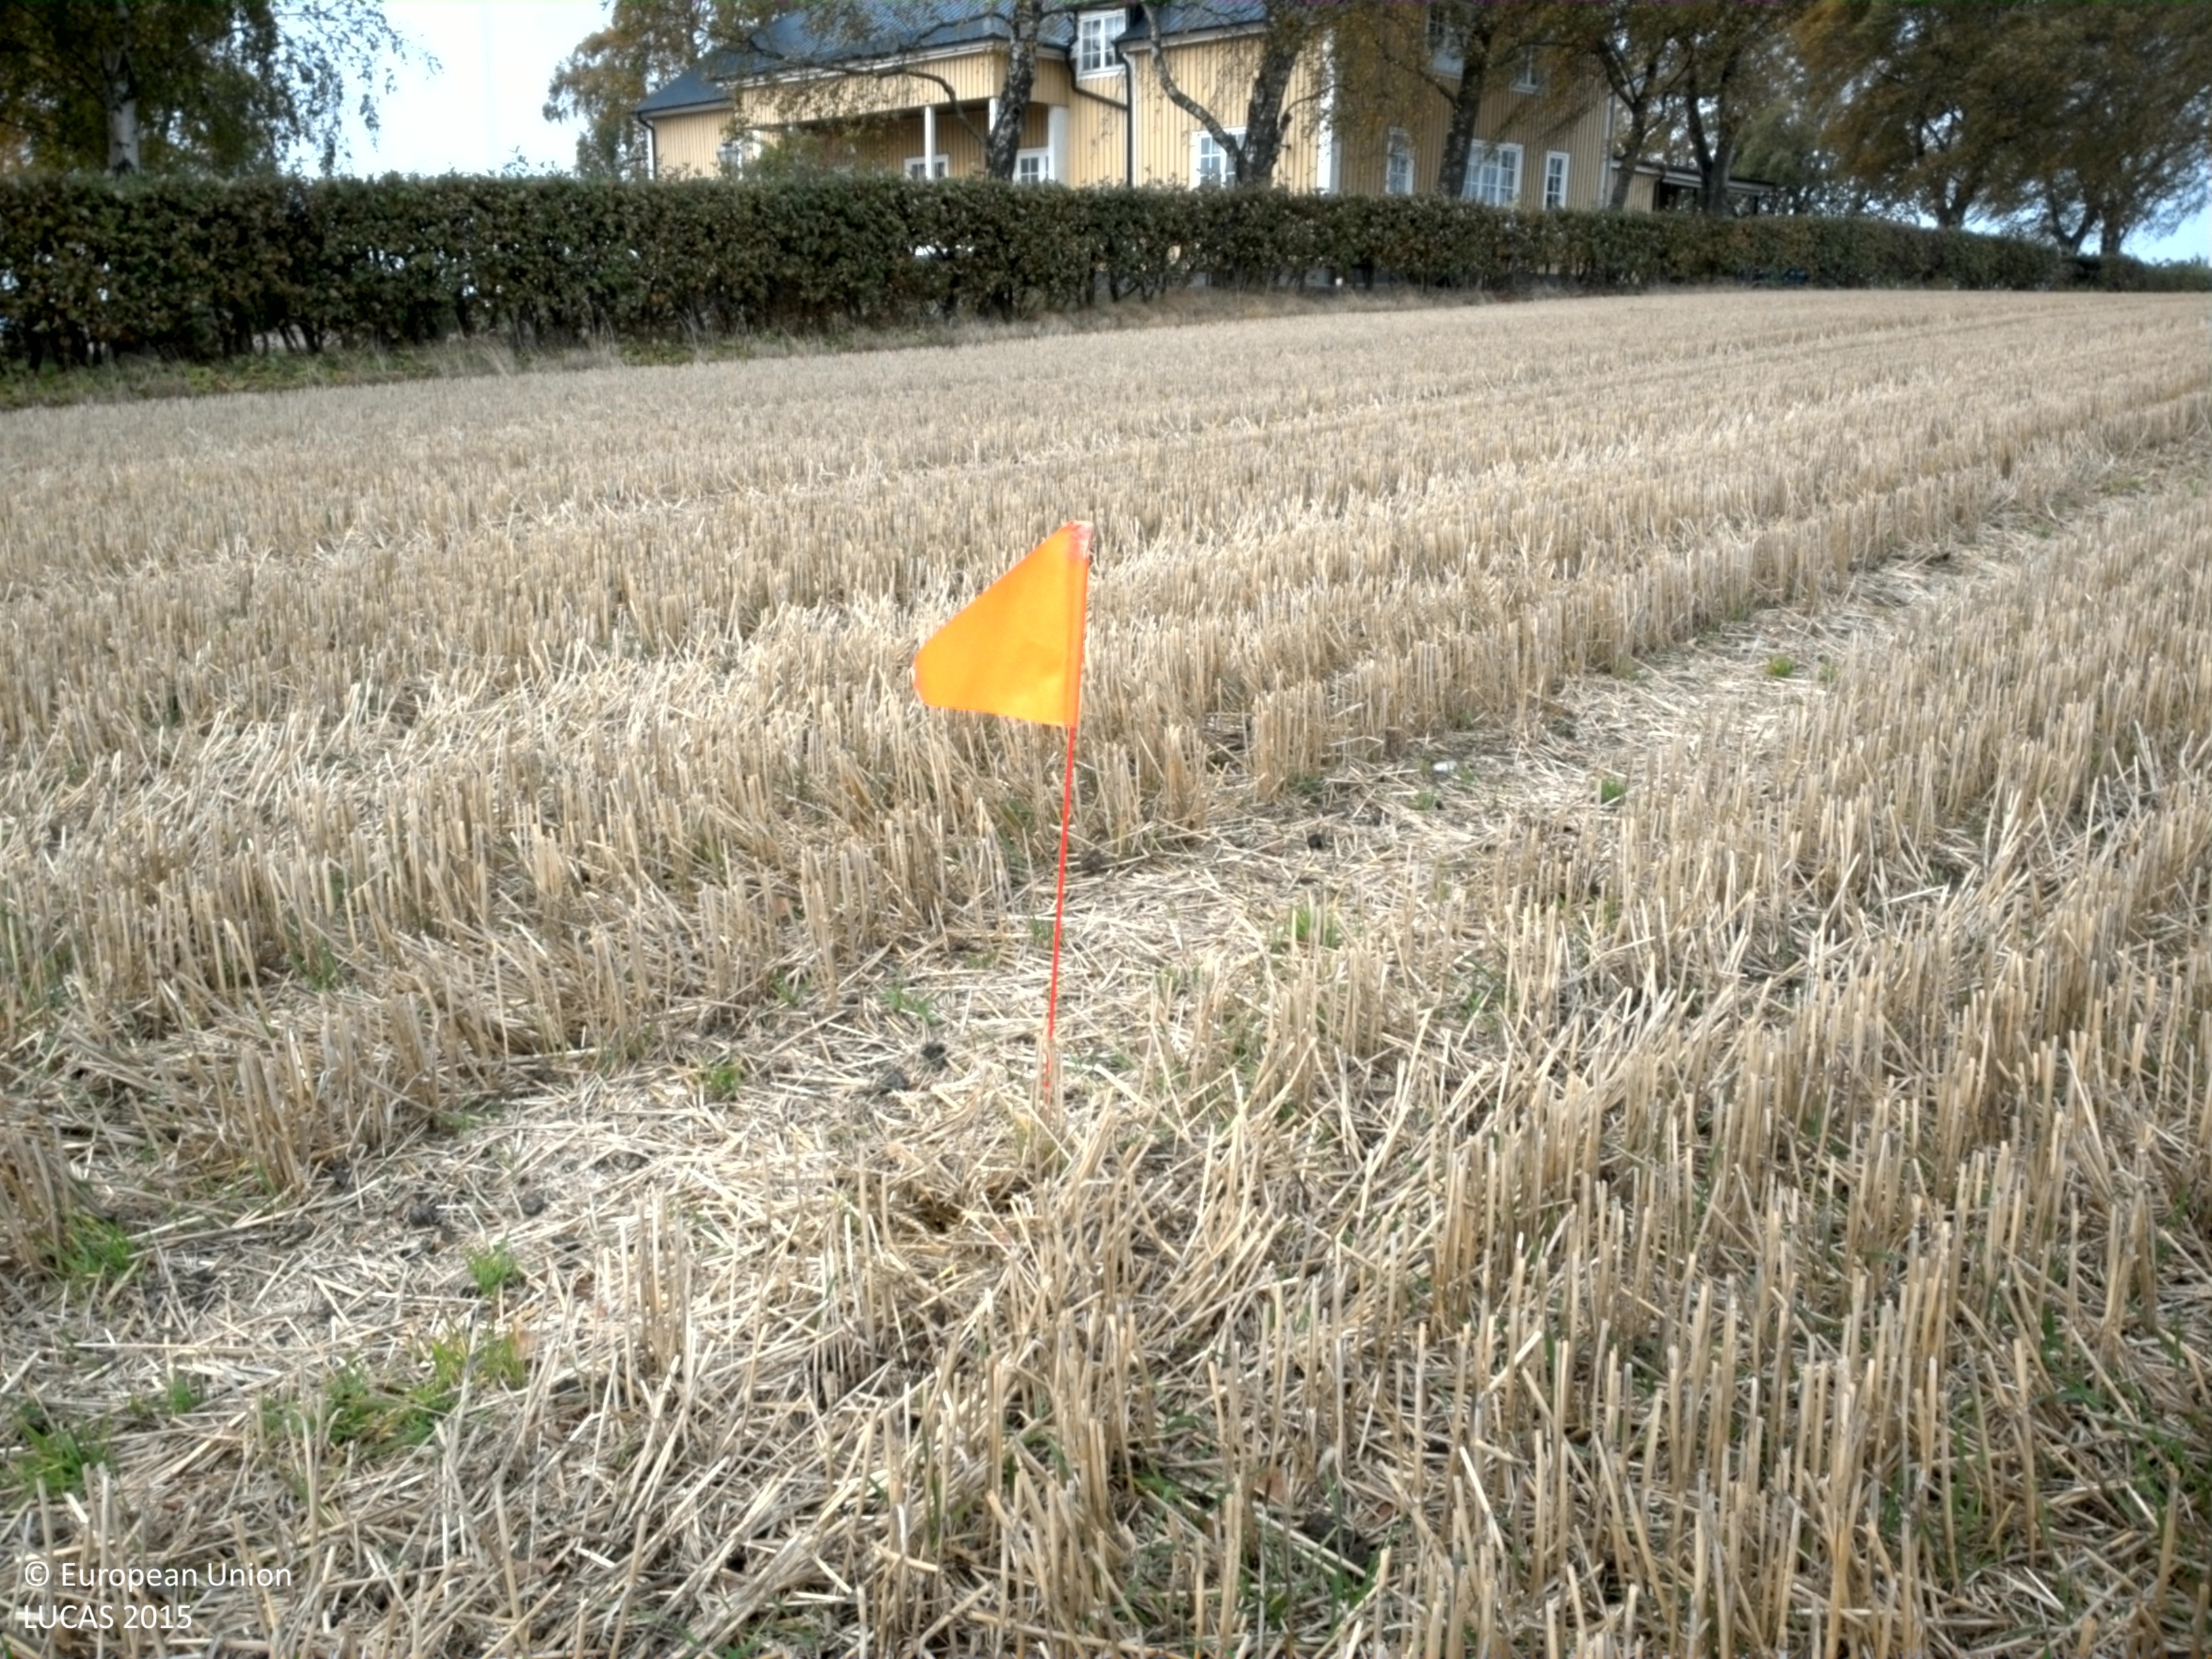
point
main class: Cropland
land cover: Common wheat
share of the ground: 10 - 25 %
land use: Agriculture (excluding fallow land and kitchen gardens)
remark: Harvested field
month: October
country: SE
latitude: 55.9153
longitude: 13.1496
